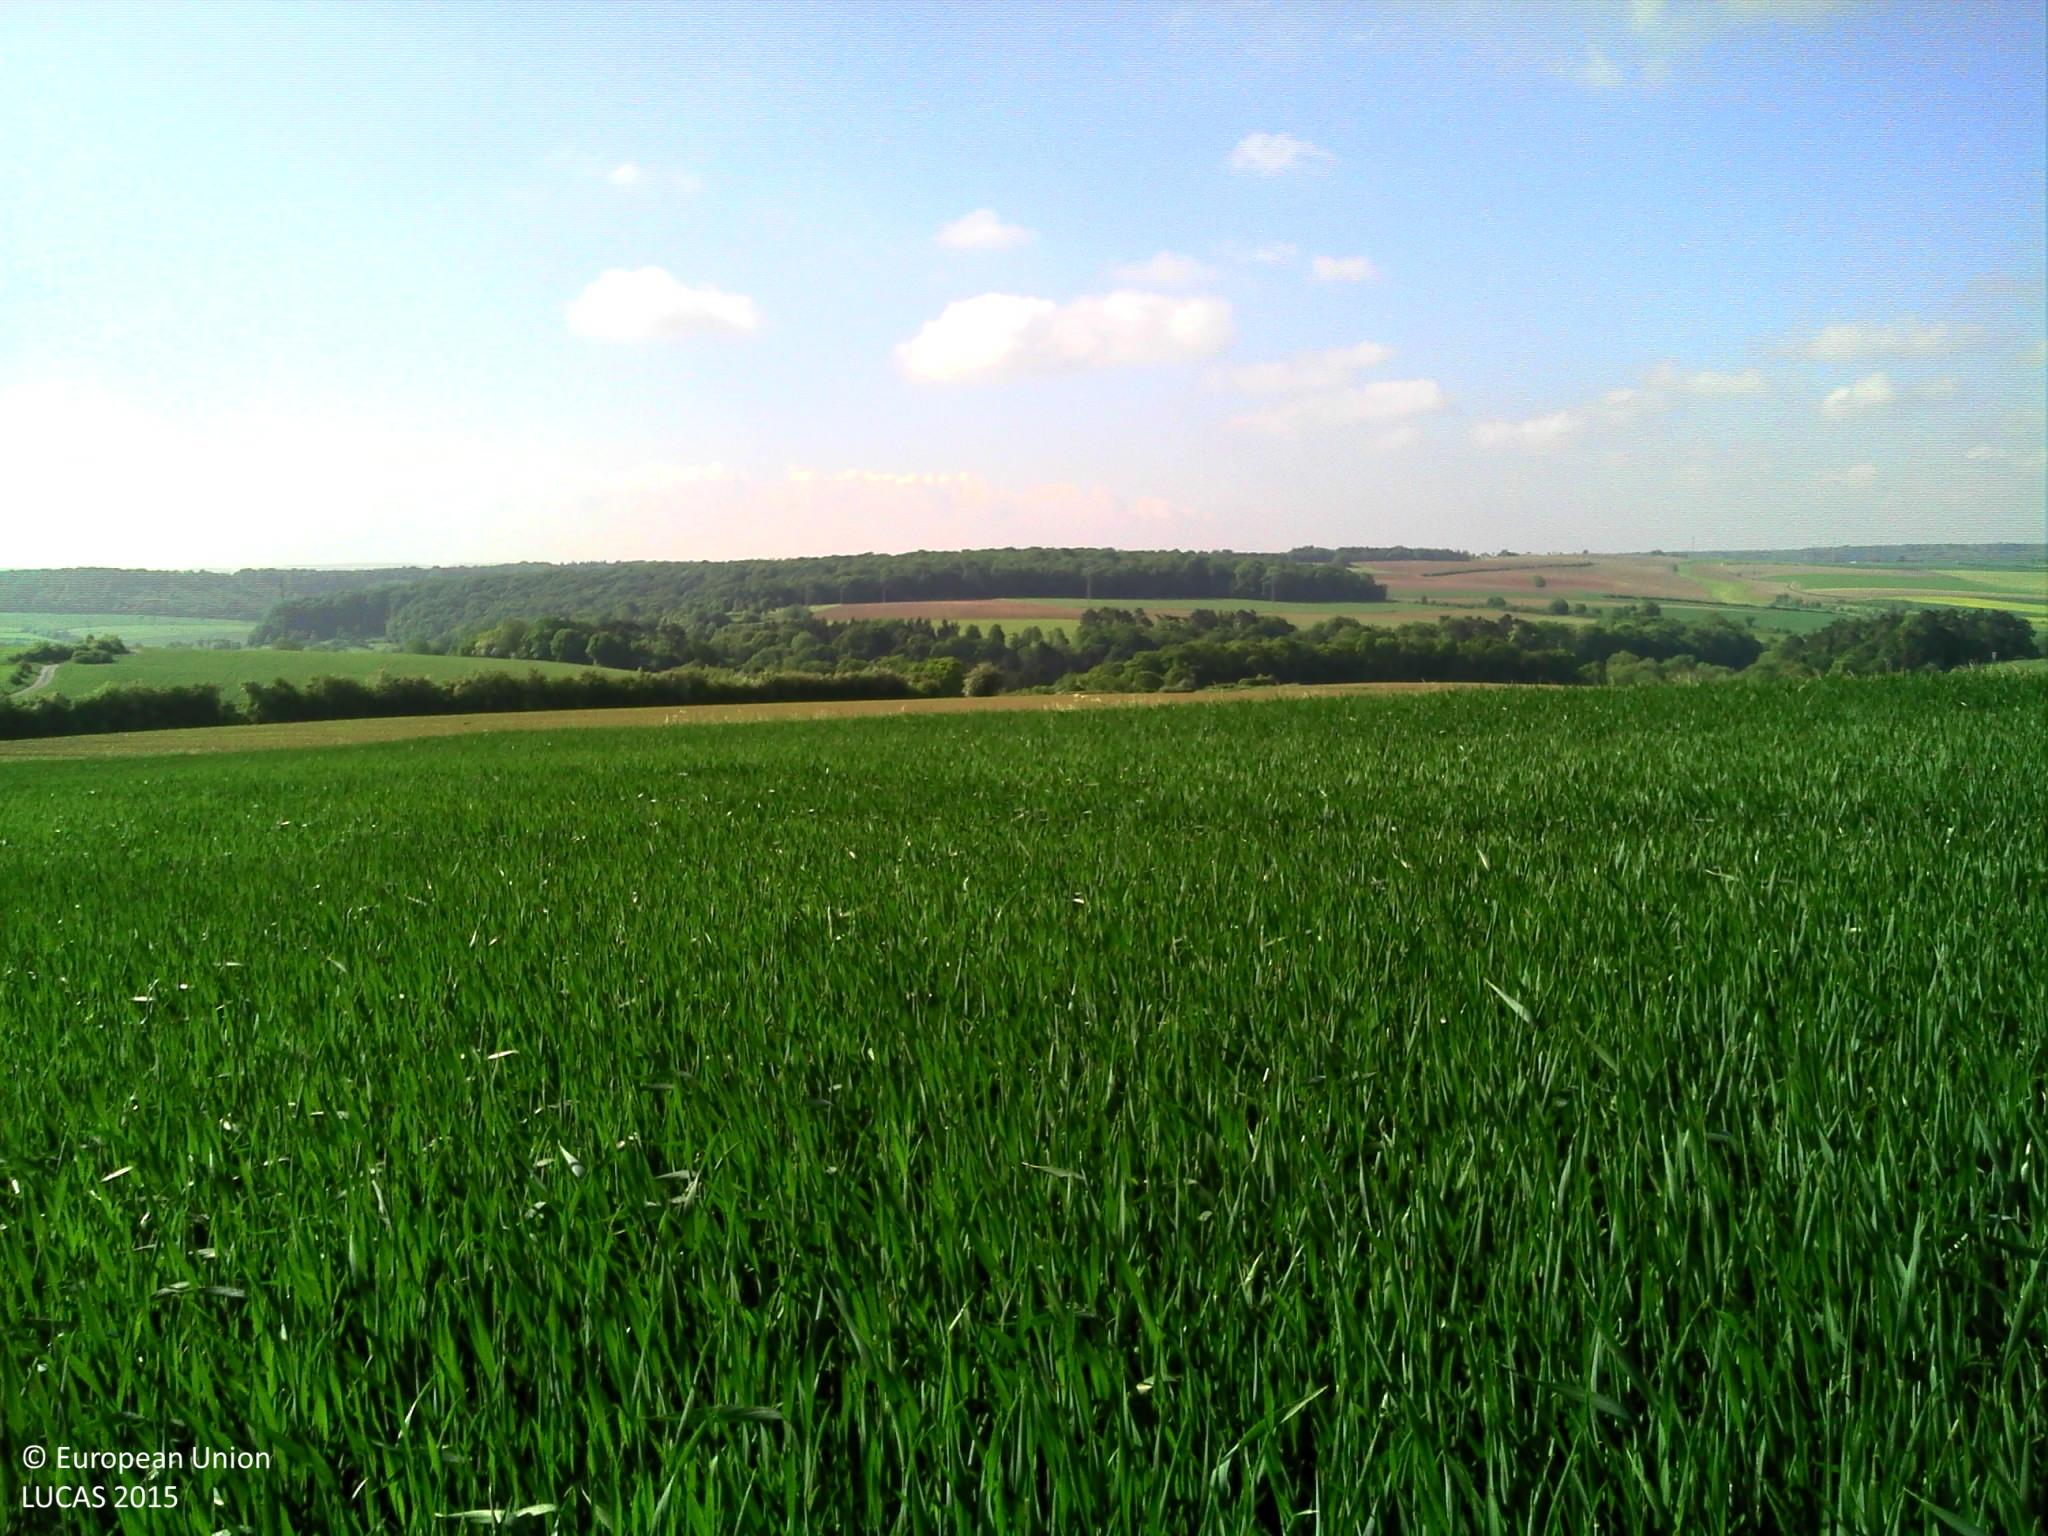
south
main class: Cropland
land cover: Common wheat
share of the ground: > 75 %
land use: Agriculture (excluding fallow land and kitchen gardens)
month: May
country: LU
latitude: 49.7137
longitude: 6.4077
